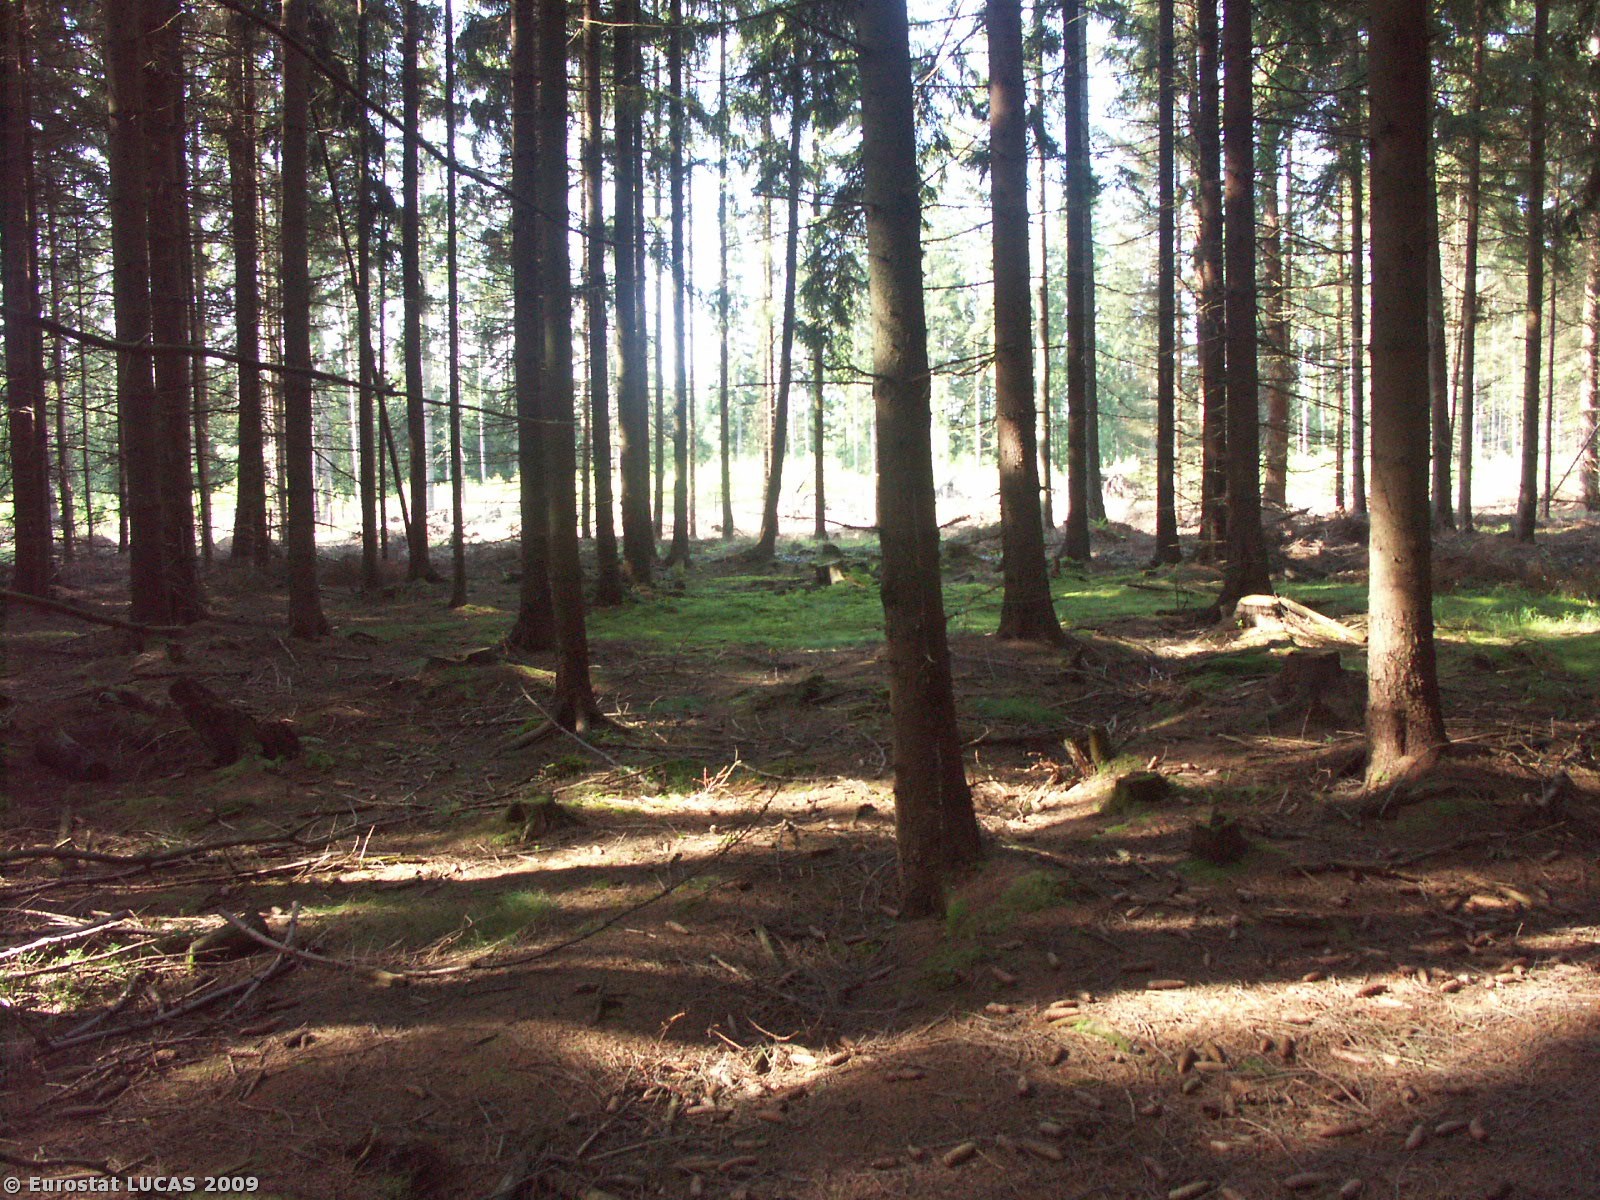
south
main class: Woodland
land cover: Coniferous woodland
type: hemiboreal forest and nemoral coniferous forest and mixed broadleaved-coniferous forest
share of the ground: > 75 %
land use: Forestry
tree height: > 5 m
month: July
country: CZ
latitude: 49.9787
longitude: 17.4167
